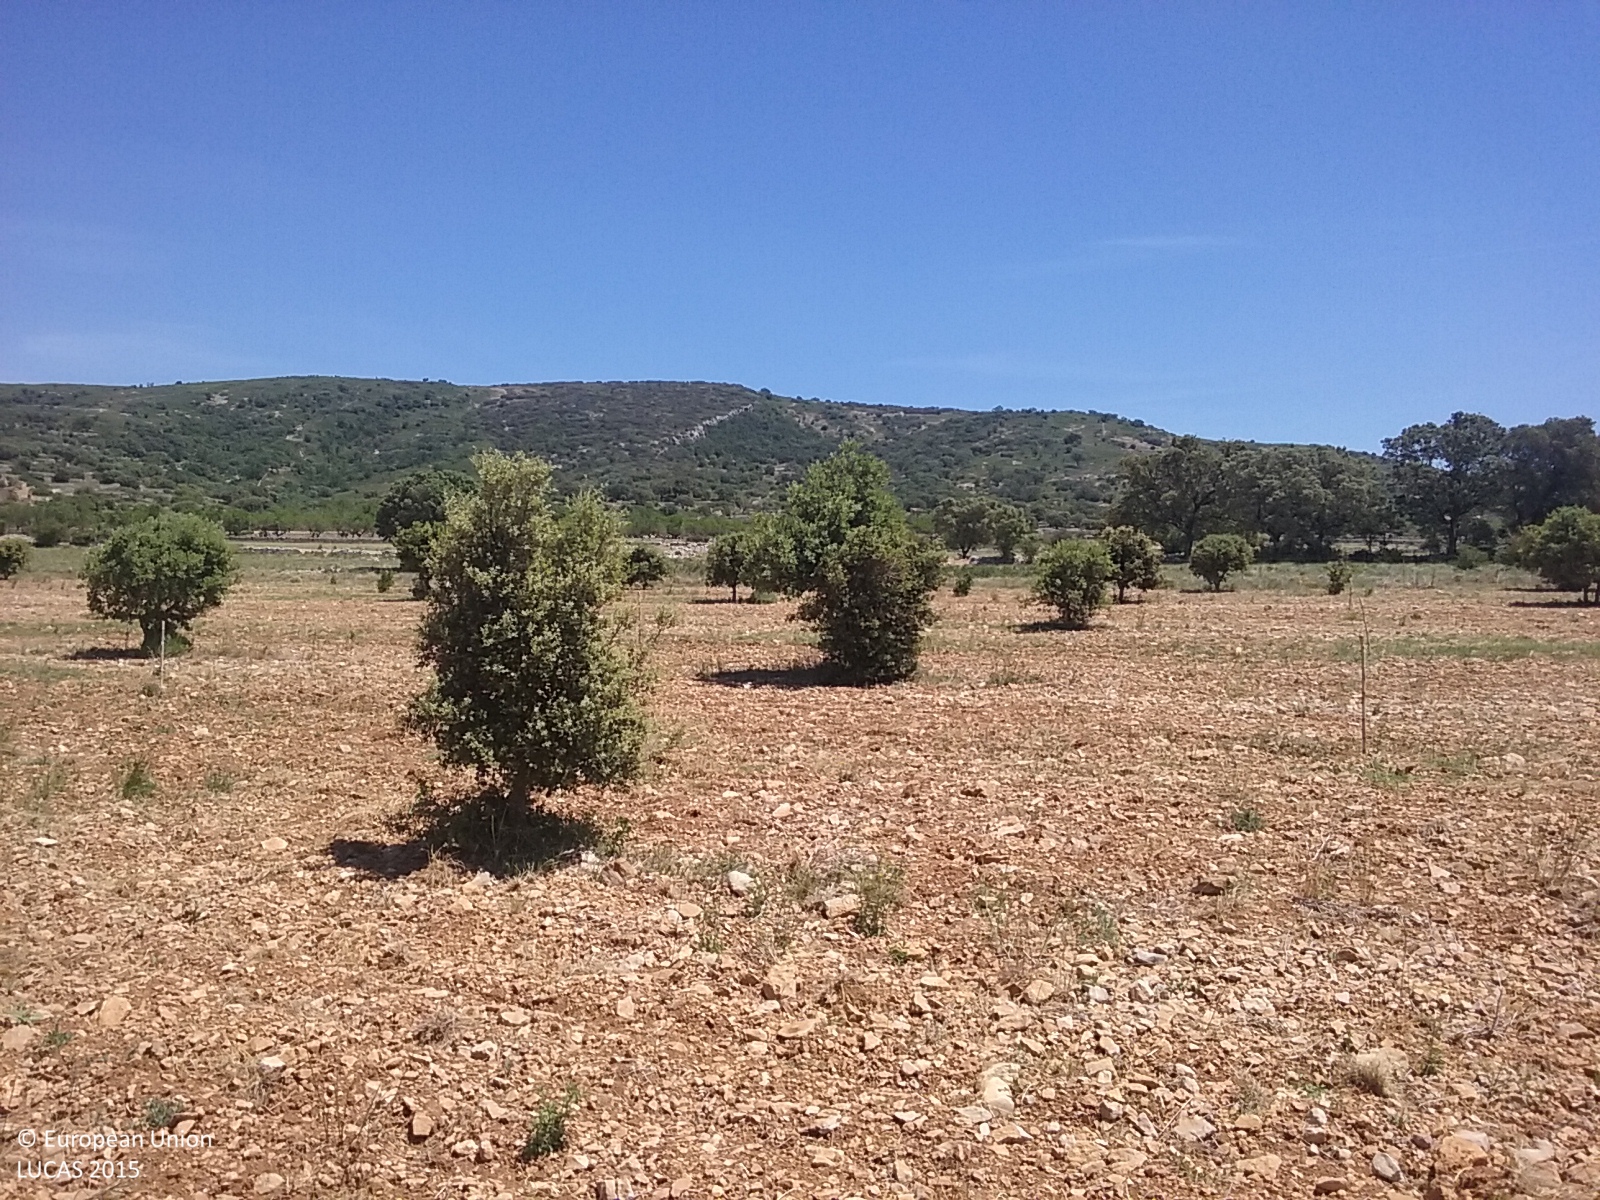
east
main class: Woodland
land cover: Broadleaved woodland
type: broadleaved evergreen forest
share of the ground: 10 - 25 %
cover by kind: unconsolidated bare surface 85 %, broadleaved forest trees 15 %
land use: Forestry
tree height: < 5 m
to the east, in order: Broadleaved woodland; Fences; Grassland without tree/shrub cover; Single bushes/trees; Grassland without tree/shrub cover; Dry stone walls; Grassland without tree/shrub cover; Fences; Dry stone walls; Nuts trees
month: May
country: ES
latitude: 40.4279
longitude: -0.0124
